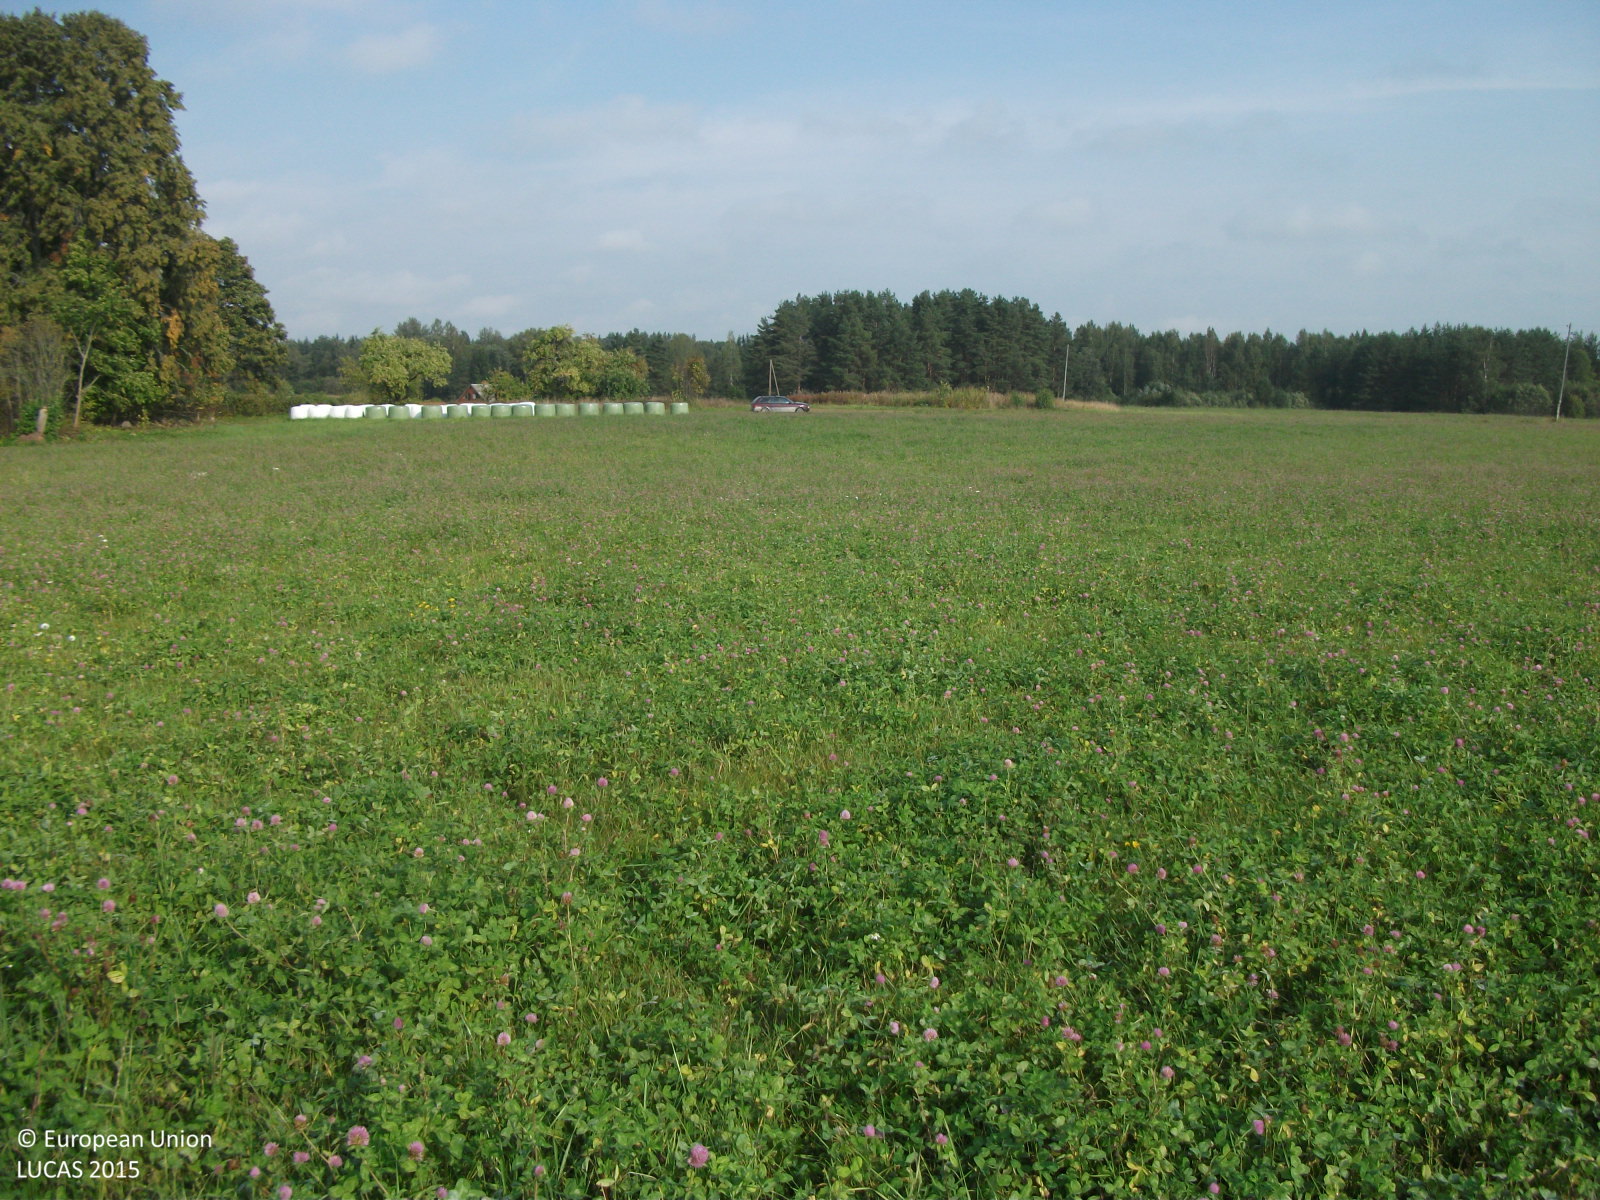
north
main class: Cropland
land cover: Clovers
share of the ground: > 75 %
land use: Agriculture (excluding fallow land and kitchen gardens)
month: September
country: LV
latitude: 57.9001
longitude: 24.8603
